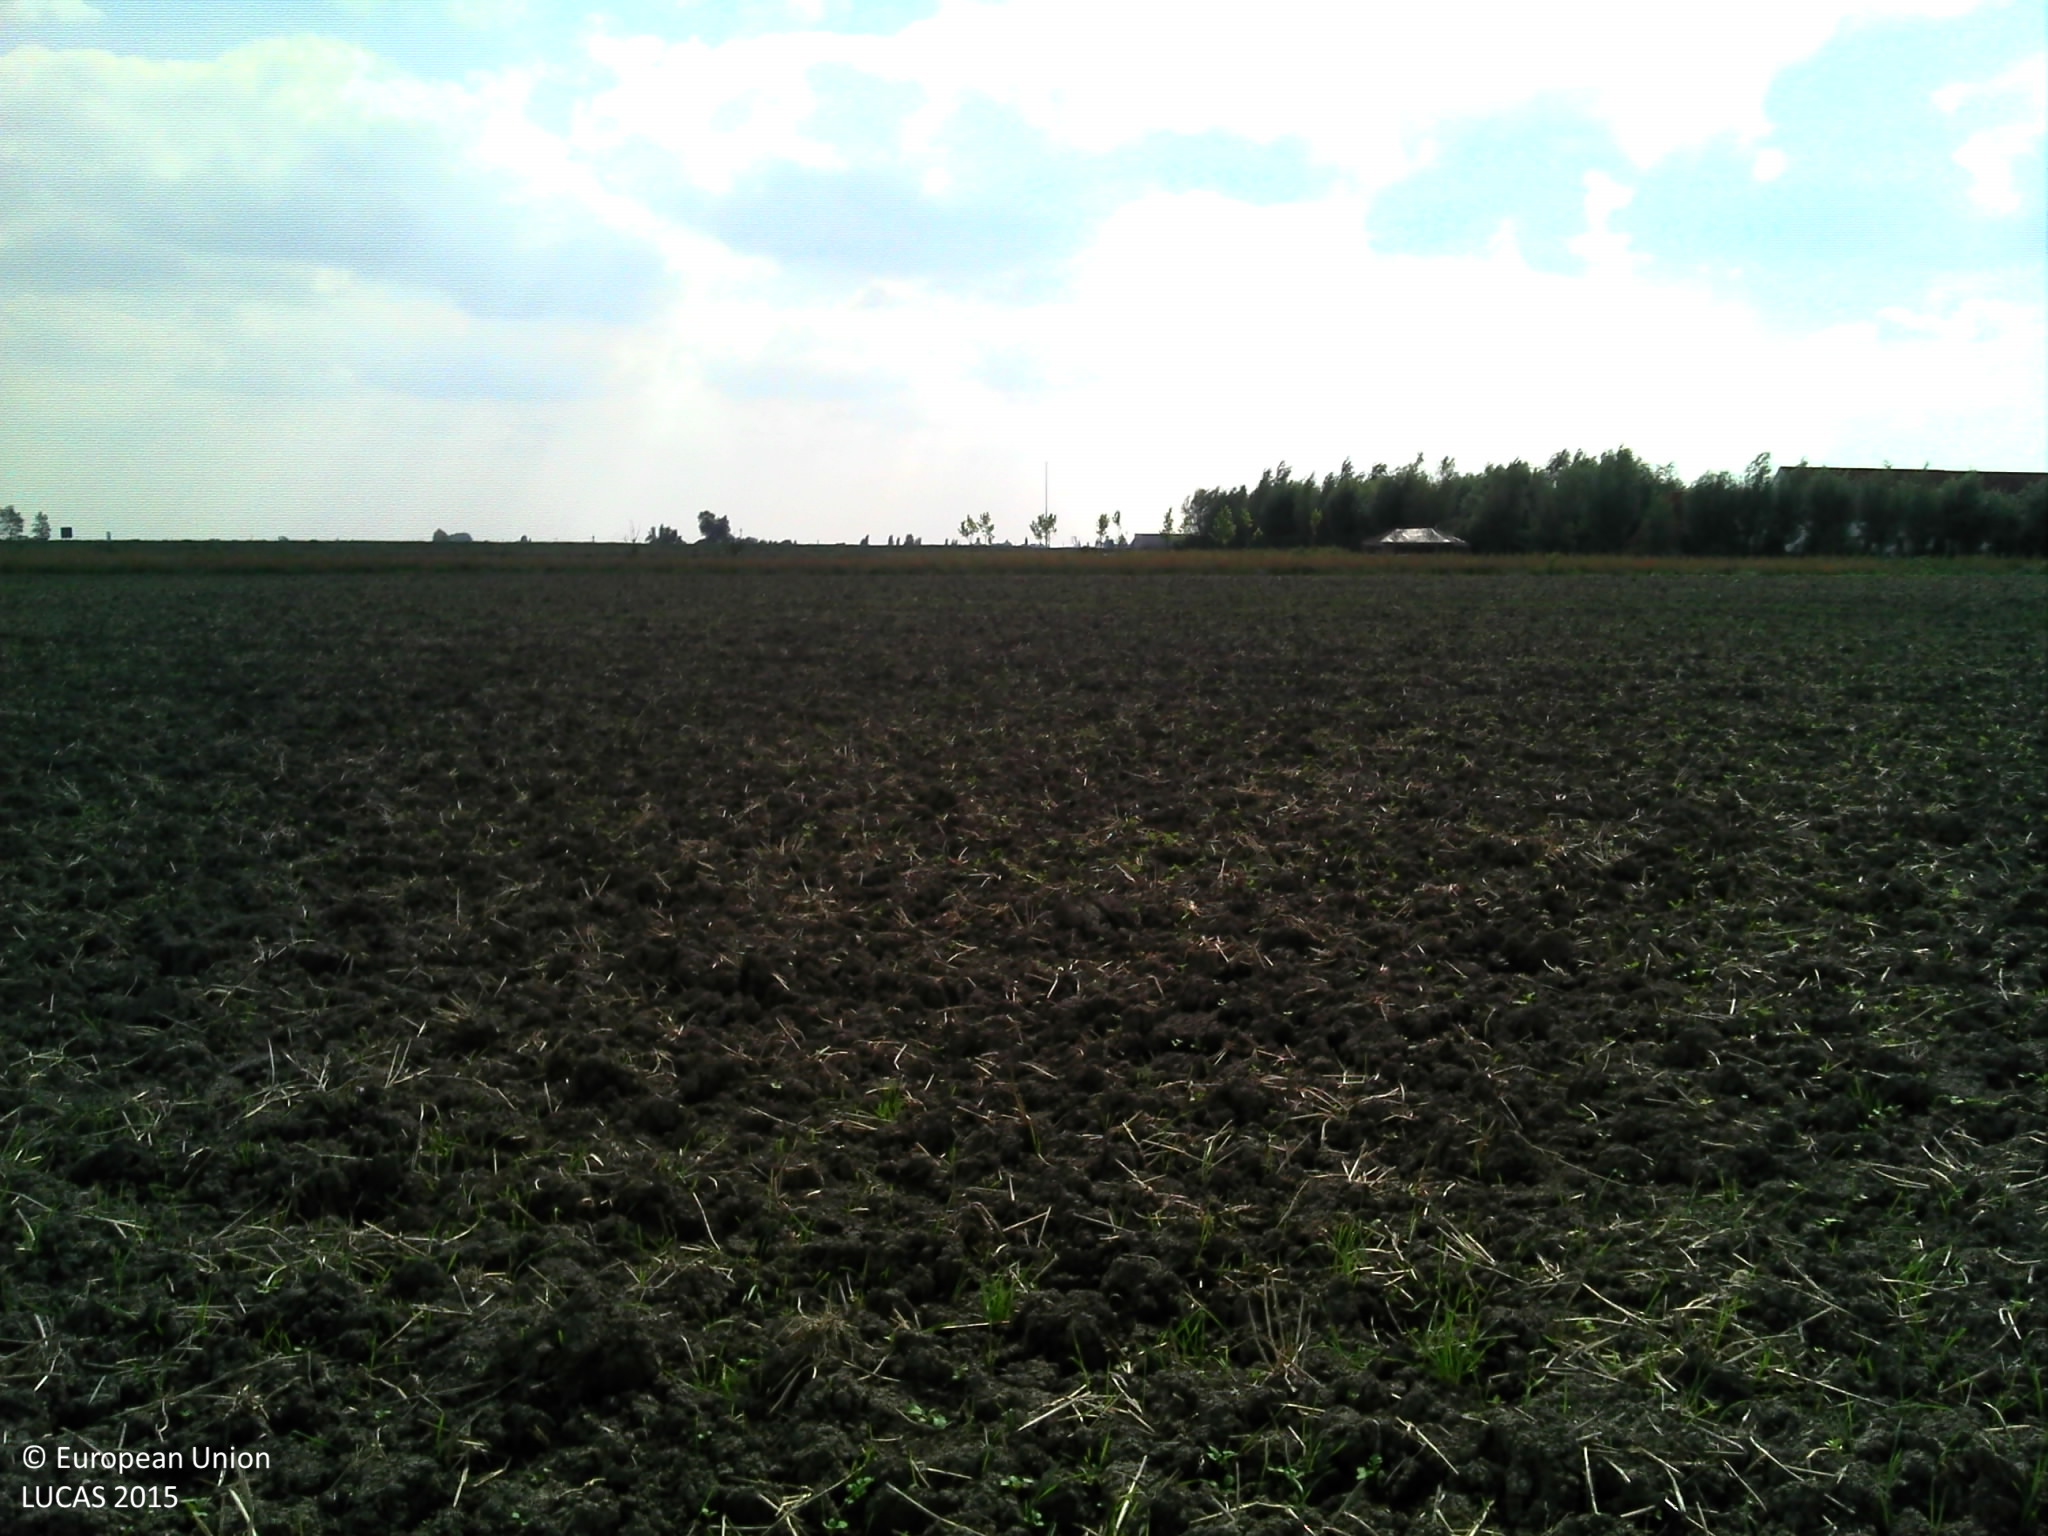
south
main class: Cropland
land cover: Common wheat
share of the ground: < 10 %
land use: Agriculture (excluding fallow land and kitchen gardens)
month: September
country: BE
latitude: 51.0889
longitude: 2.7214
